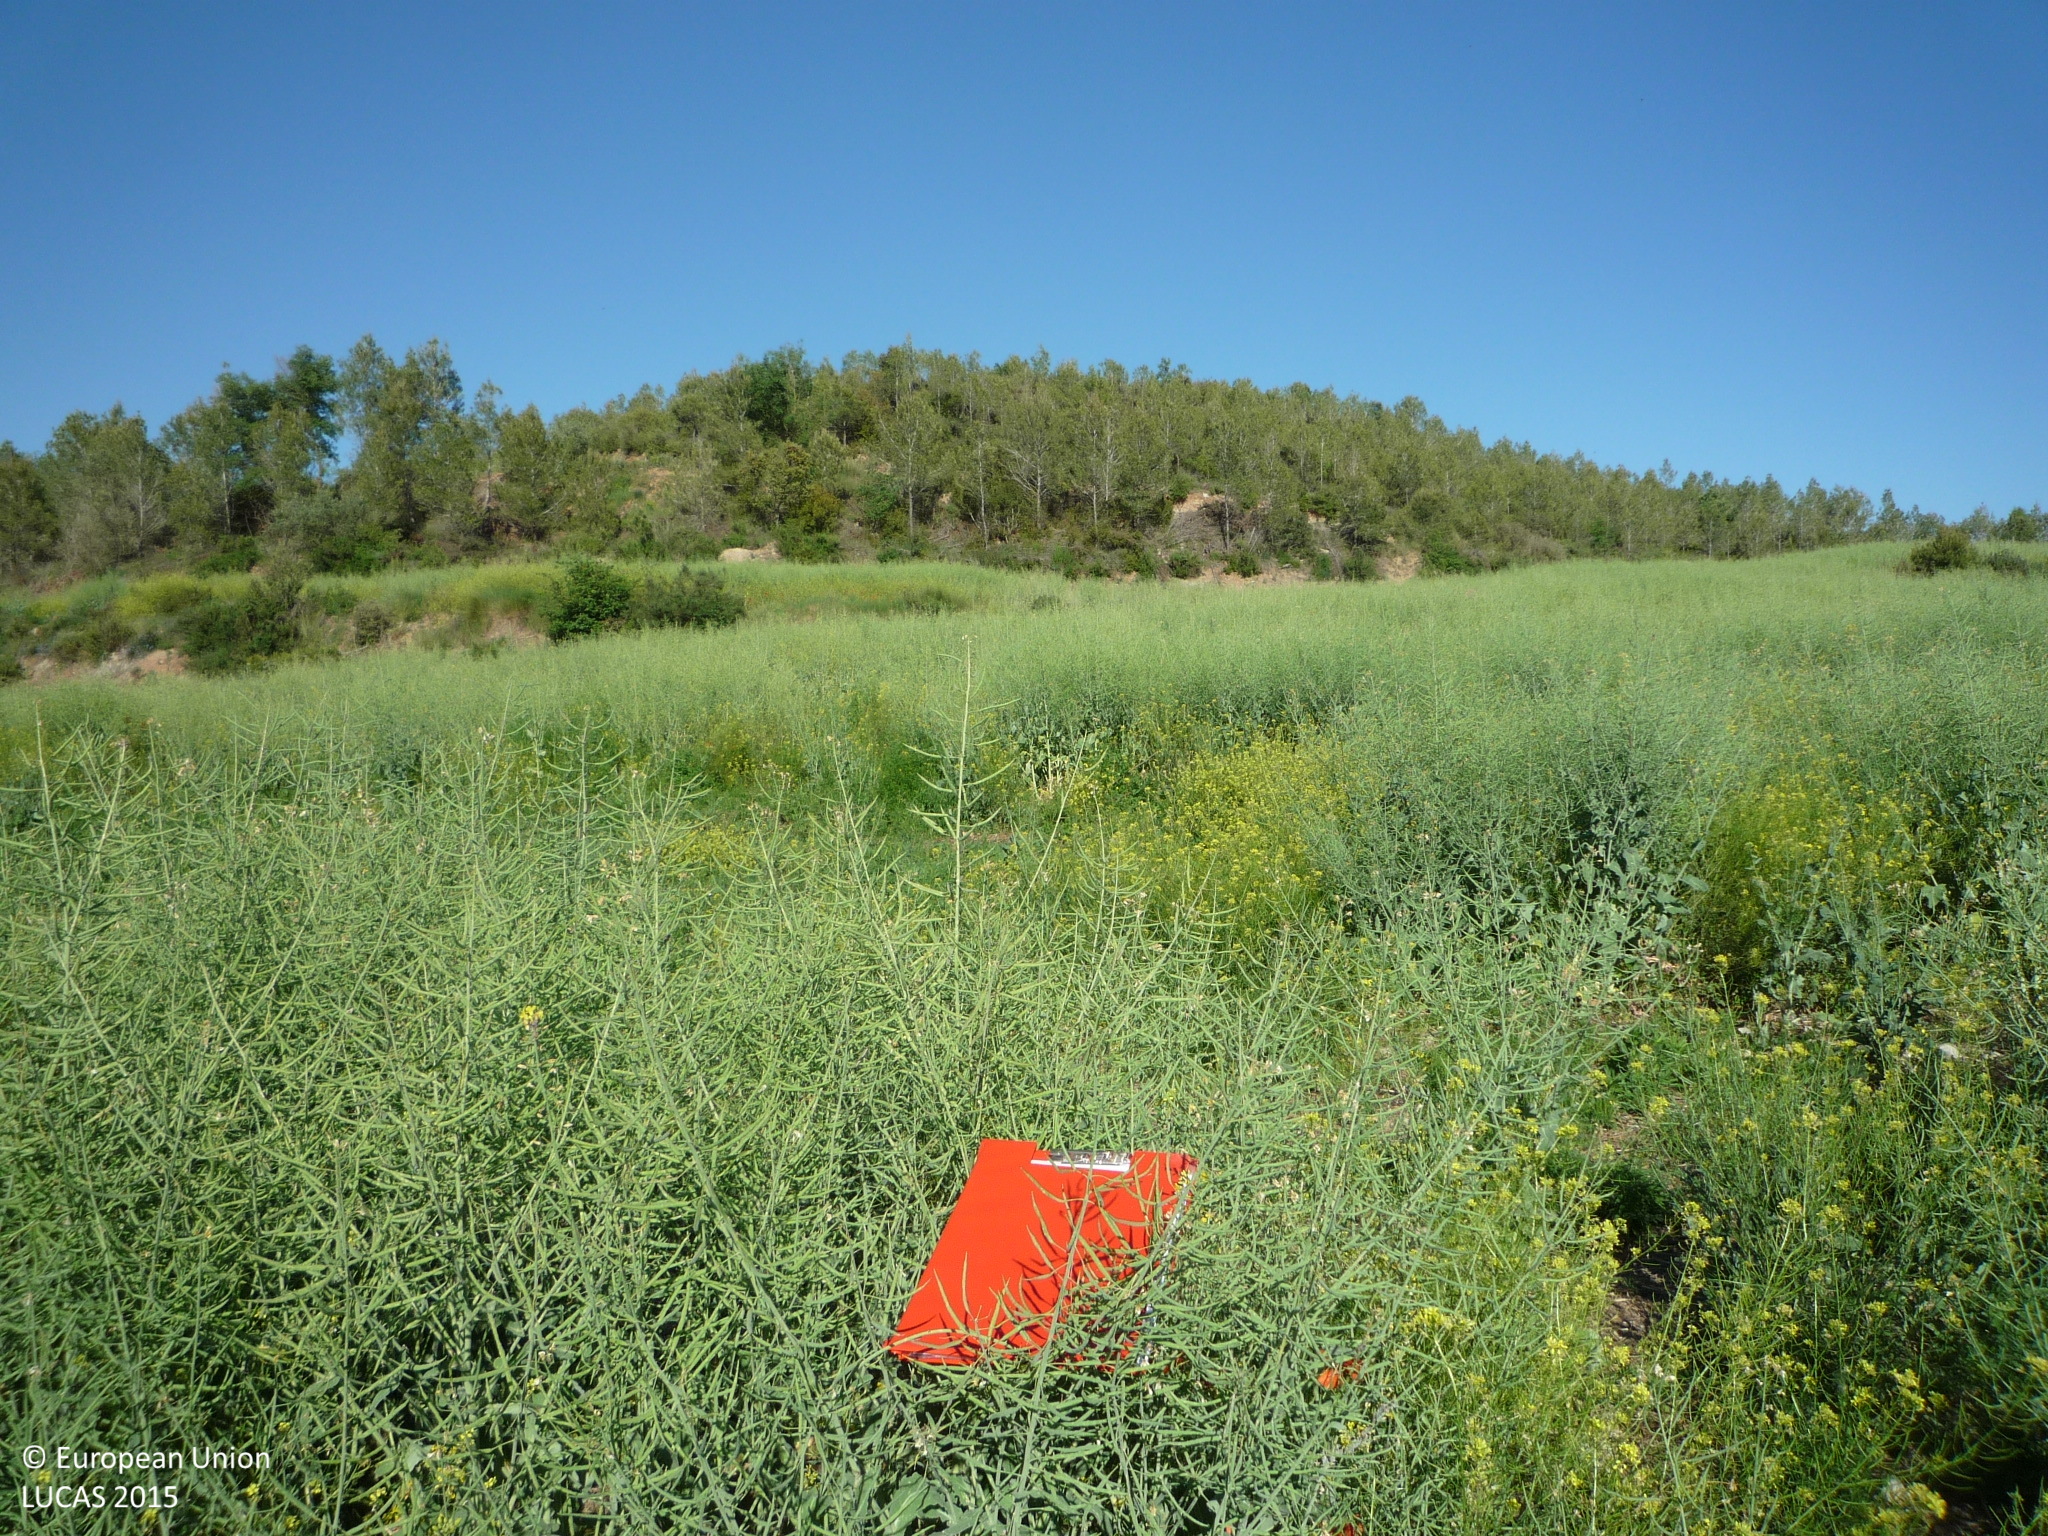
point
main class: Cropland
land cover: Rape and turnip rape
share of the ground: > 75 %
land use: Agriculture (excluding fallow land and kitchen gardens)
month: May
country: ES
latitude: 41.7905
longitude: 1.7476
